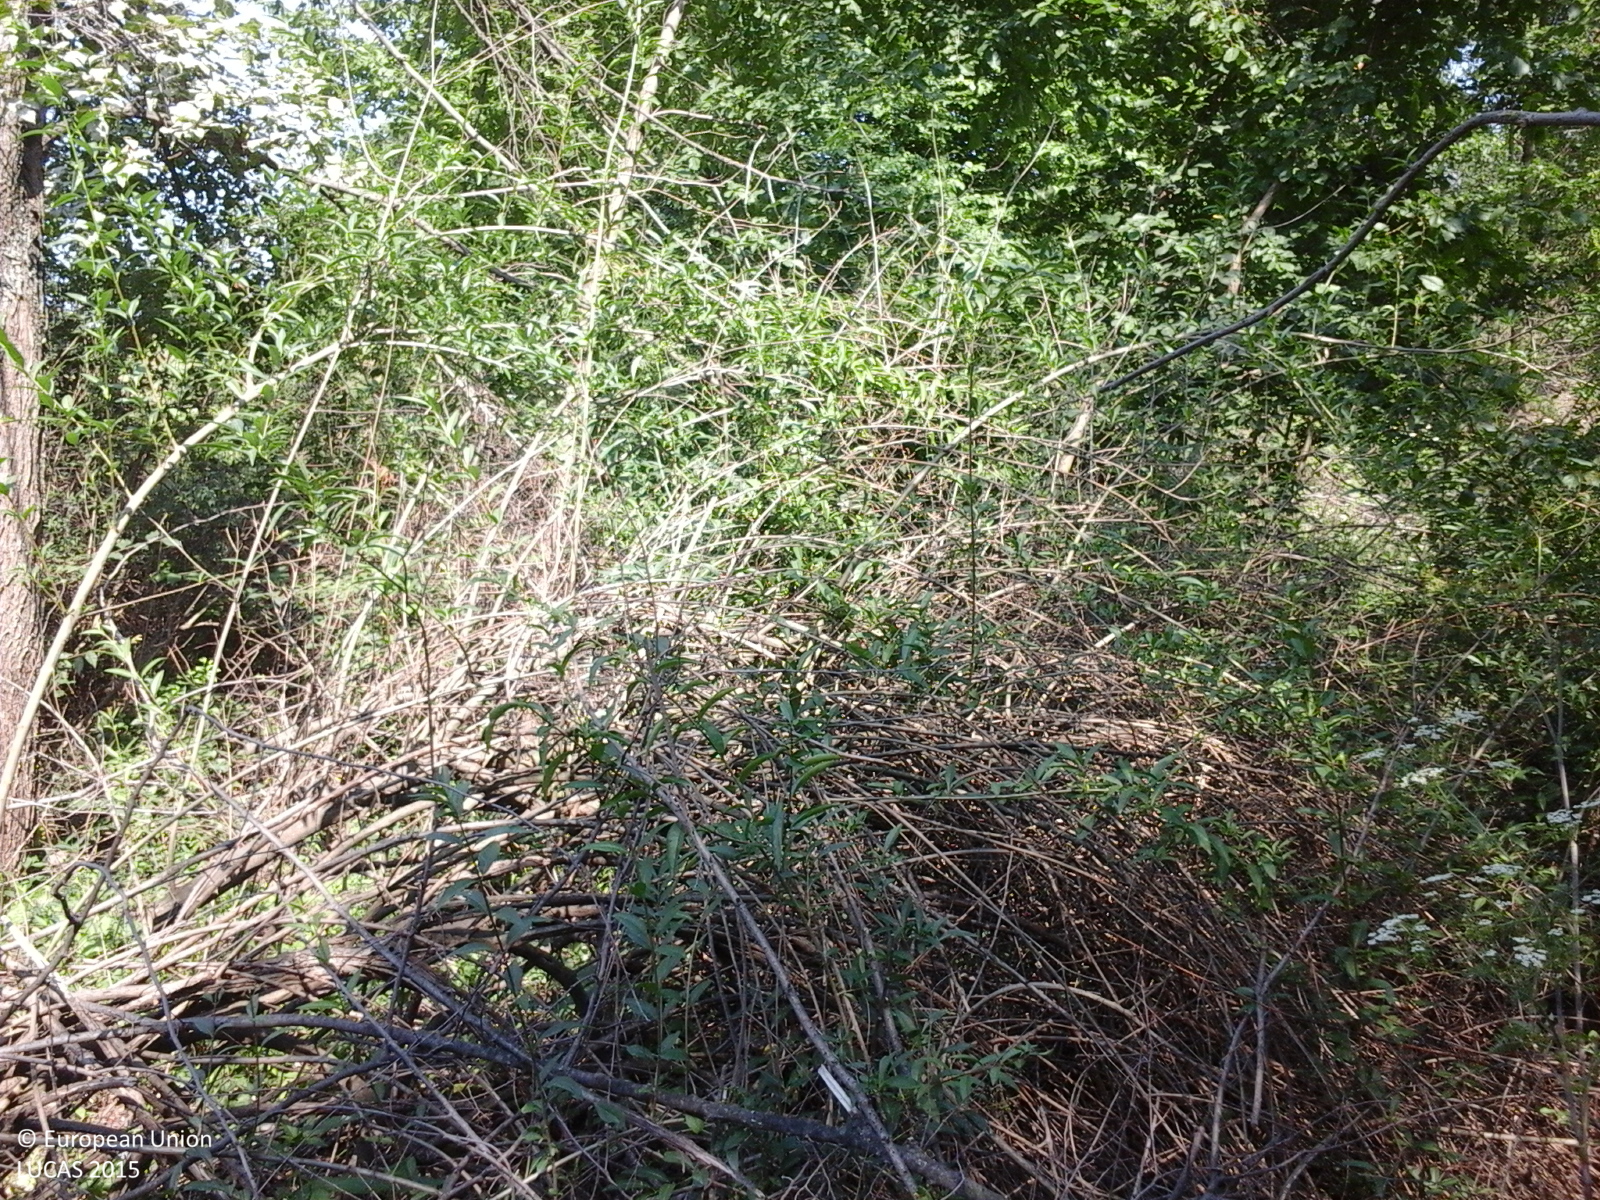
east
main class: Woodland
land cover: Broadleaved woodland
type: floodplain forest
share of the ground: > 75 %
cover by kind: broadleaved forest trees 90 %, shrubs 5 %, herbaceous plants 5 %
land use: Forestry
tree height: < 5 m
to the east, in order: Broadleaved woodland; Grass margins; Paved roads, cycling and walking lanes; Grassland with sparse tree/shrub cover; Shrubland with sparse tree cover; Maize
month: July
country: RO
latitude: 44.7304
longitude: 24.7891
